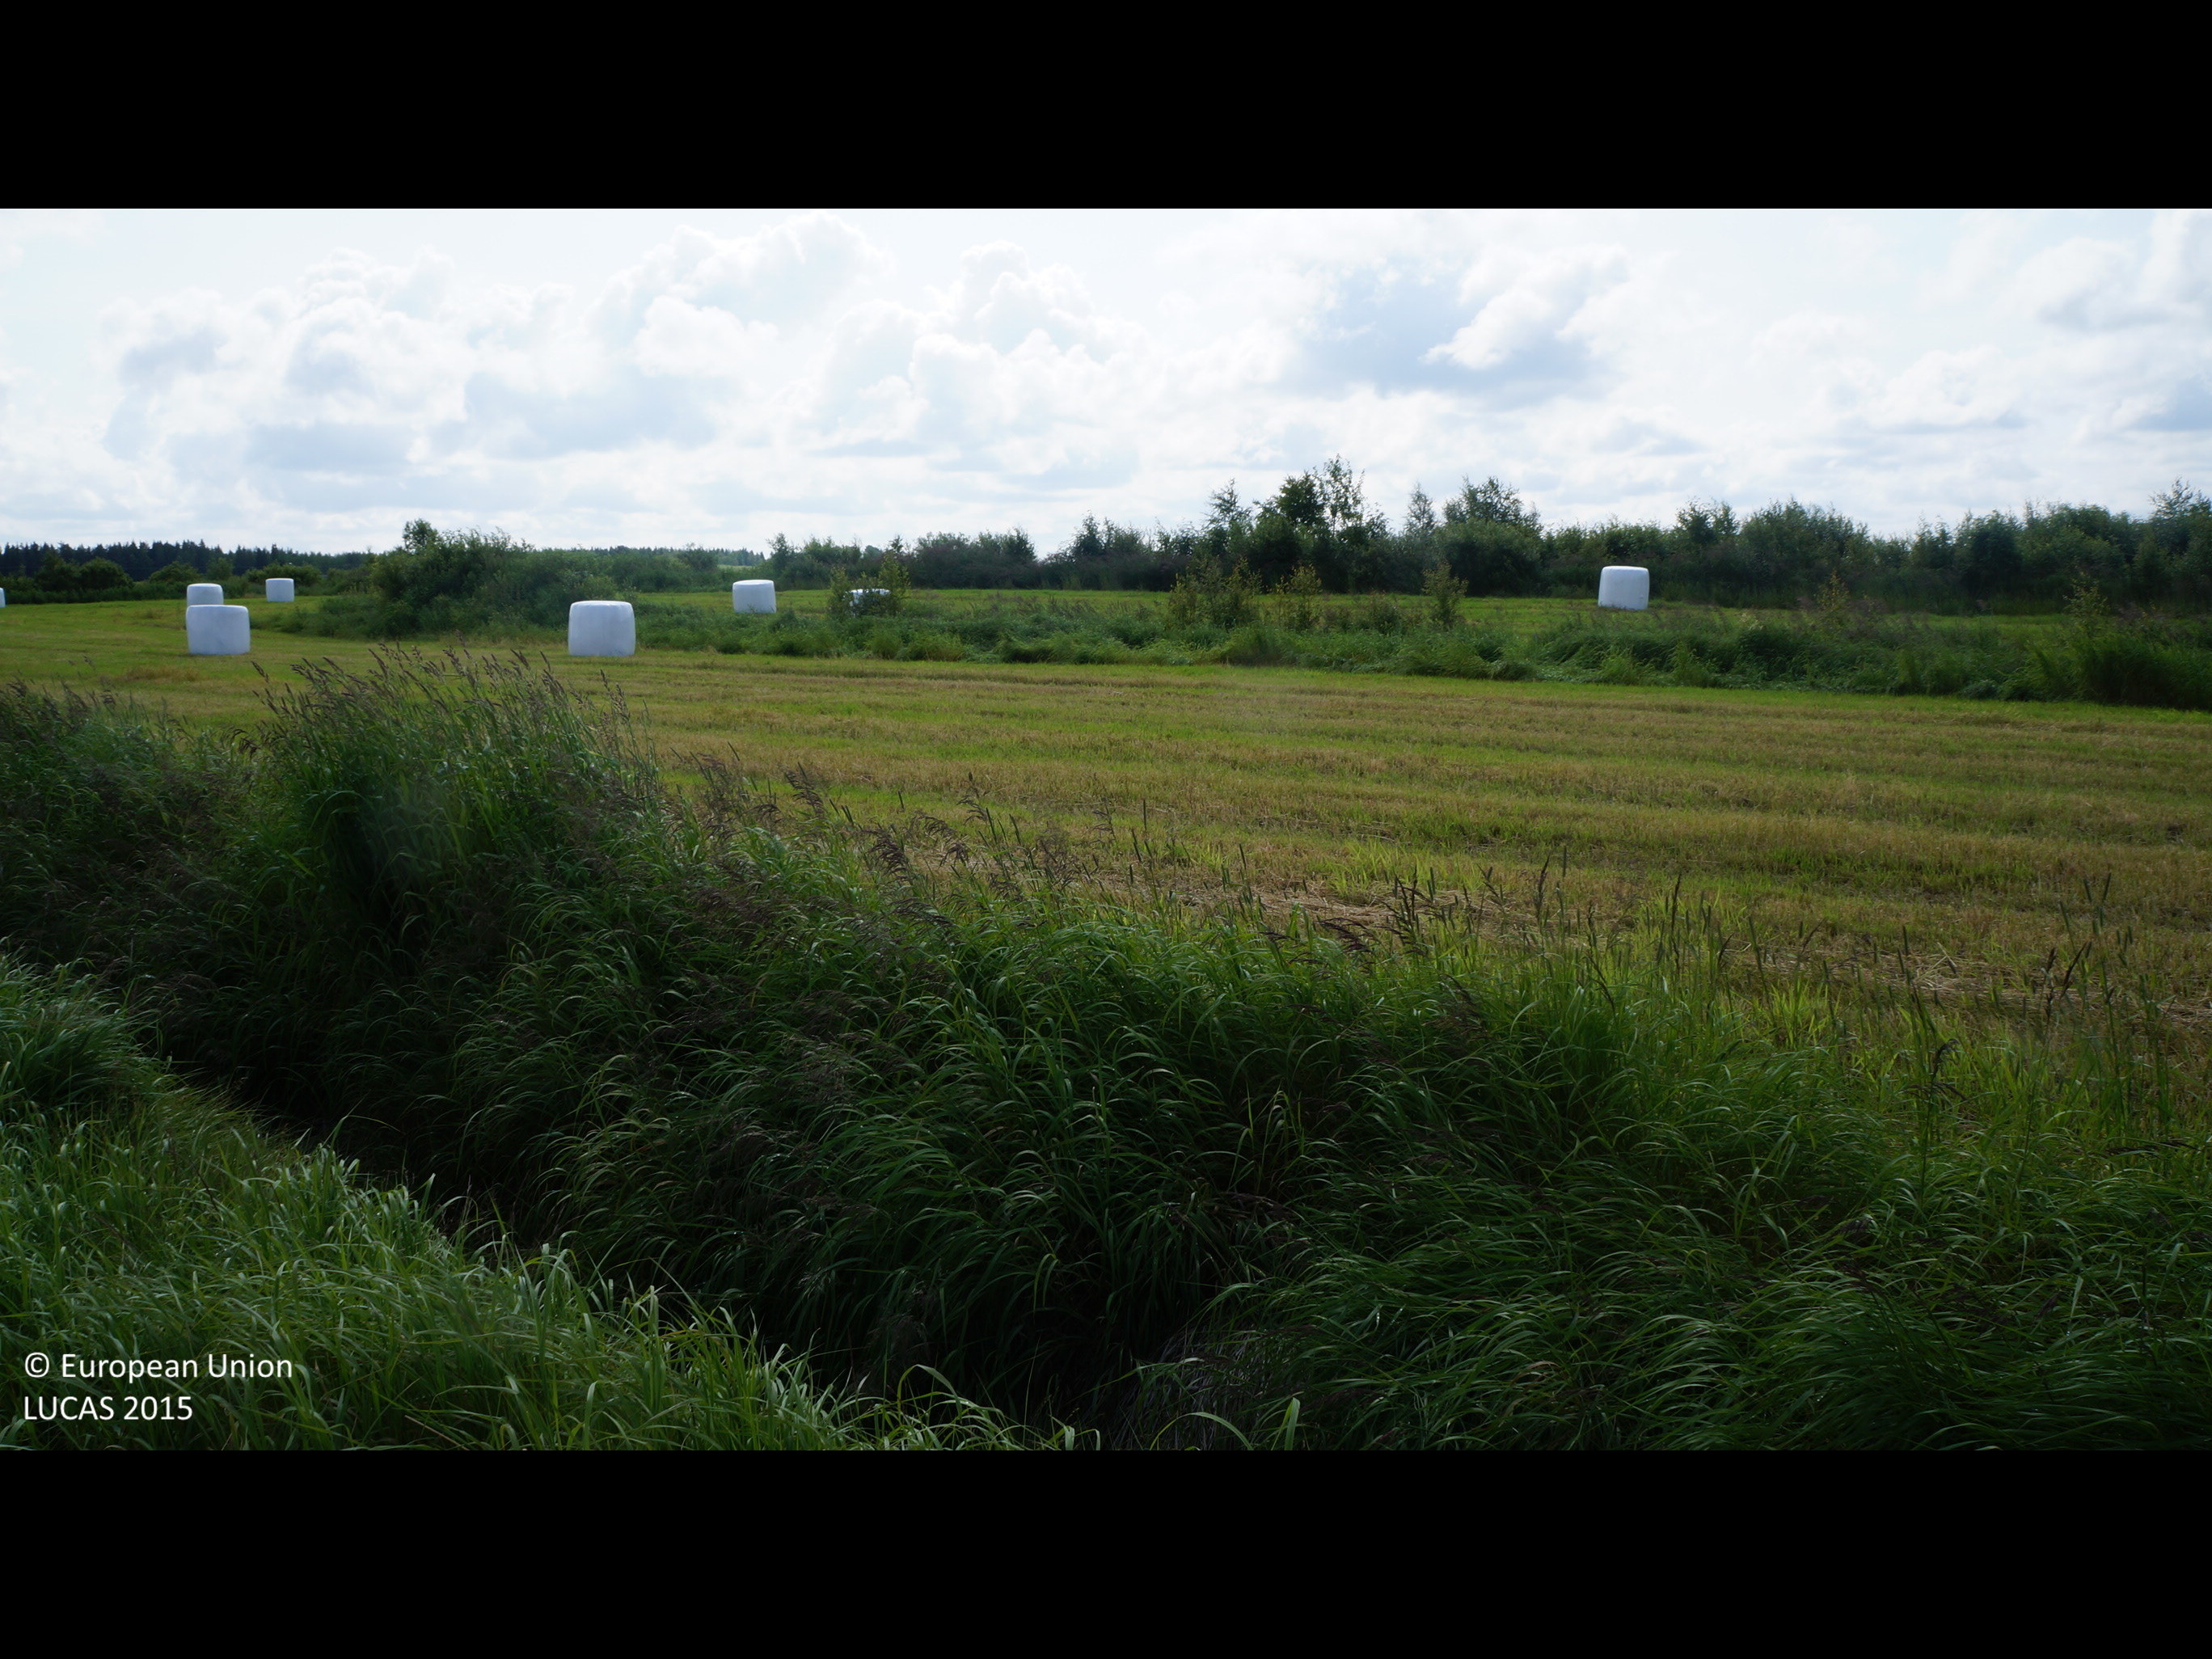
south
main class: Cropland
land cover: Temporary grasslands
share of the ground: > 75 %
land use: Agriculture (excluding fallow land and kitchen gardens)
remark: Harvested field
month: July
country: FI
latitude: 64.1601
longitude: 24.4039
